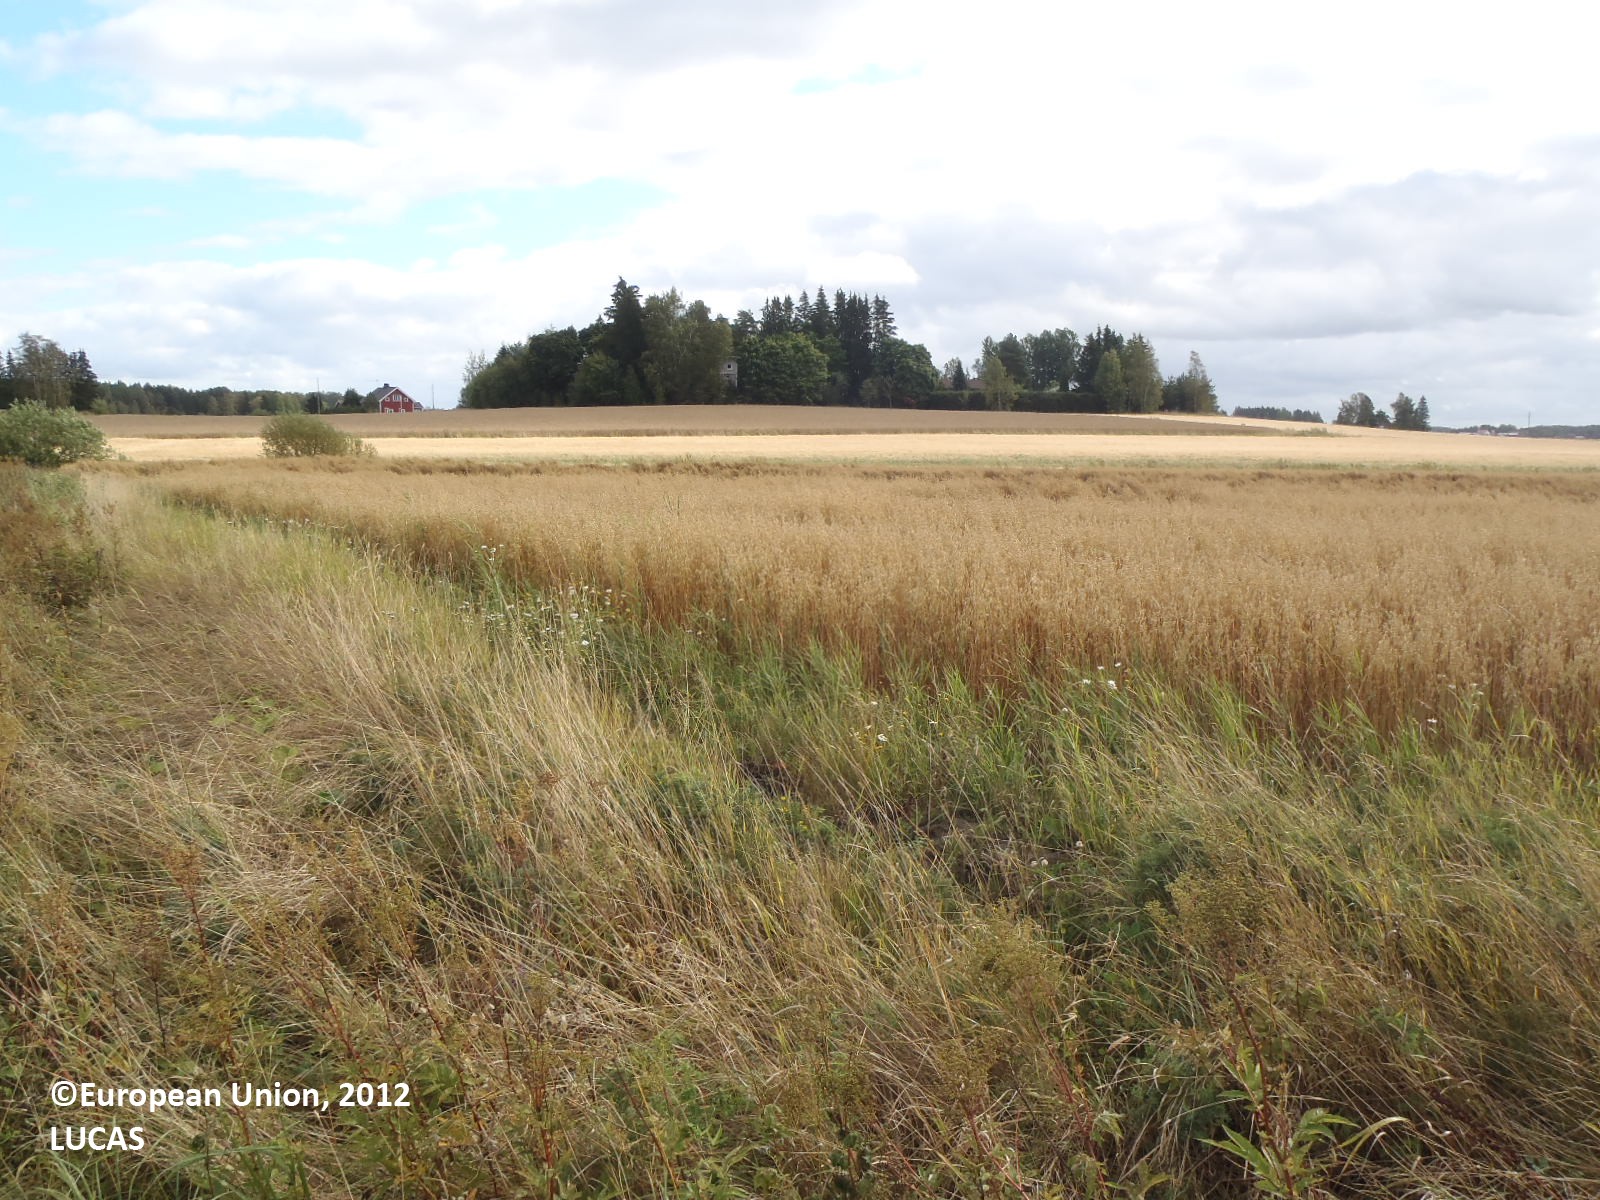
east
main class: Cropland
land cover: Common wheat
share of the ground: > 75 %
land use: Agriculture (excluding fallow land and kitchen gardens)
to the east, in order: Common wheat; Grass margins; Ditches and canals; Grass margins; Common wheat
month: September
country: FI
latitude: 61.2708
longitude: 22.6560
